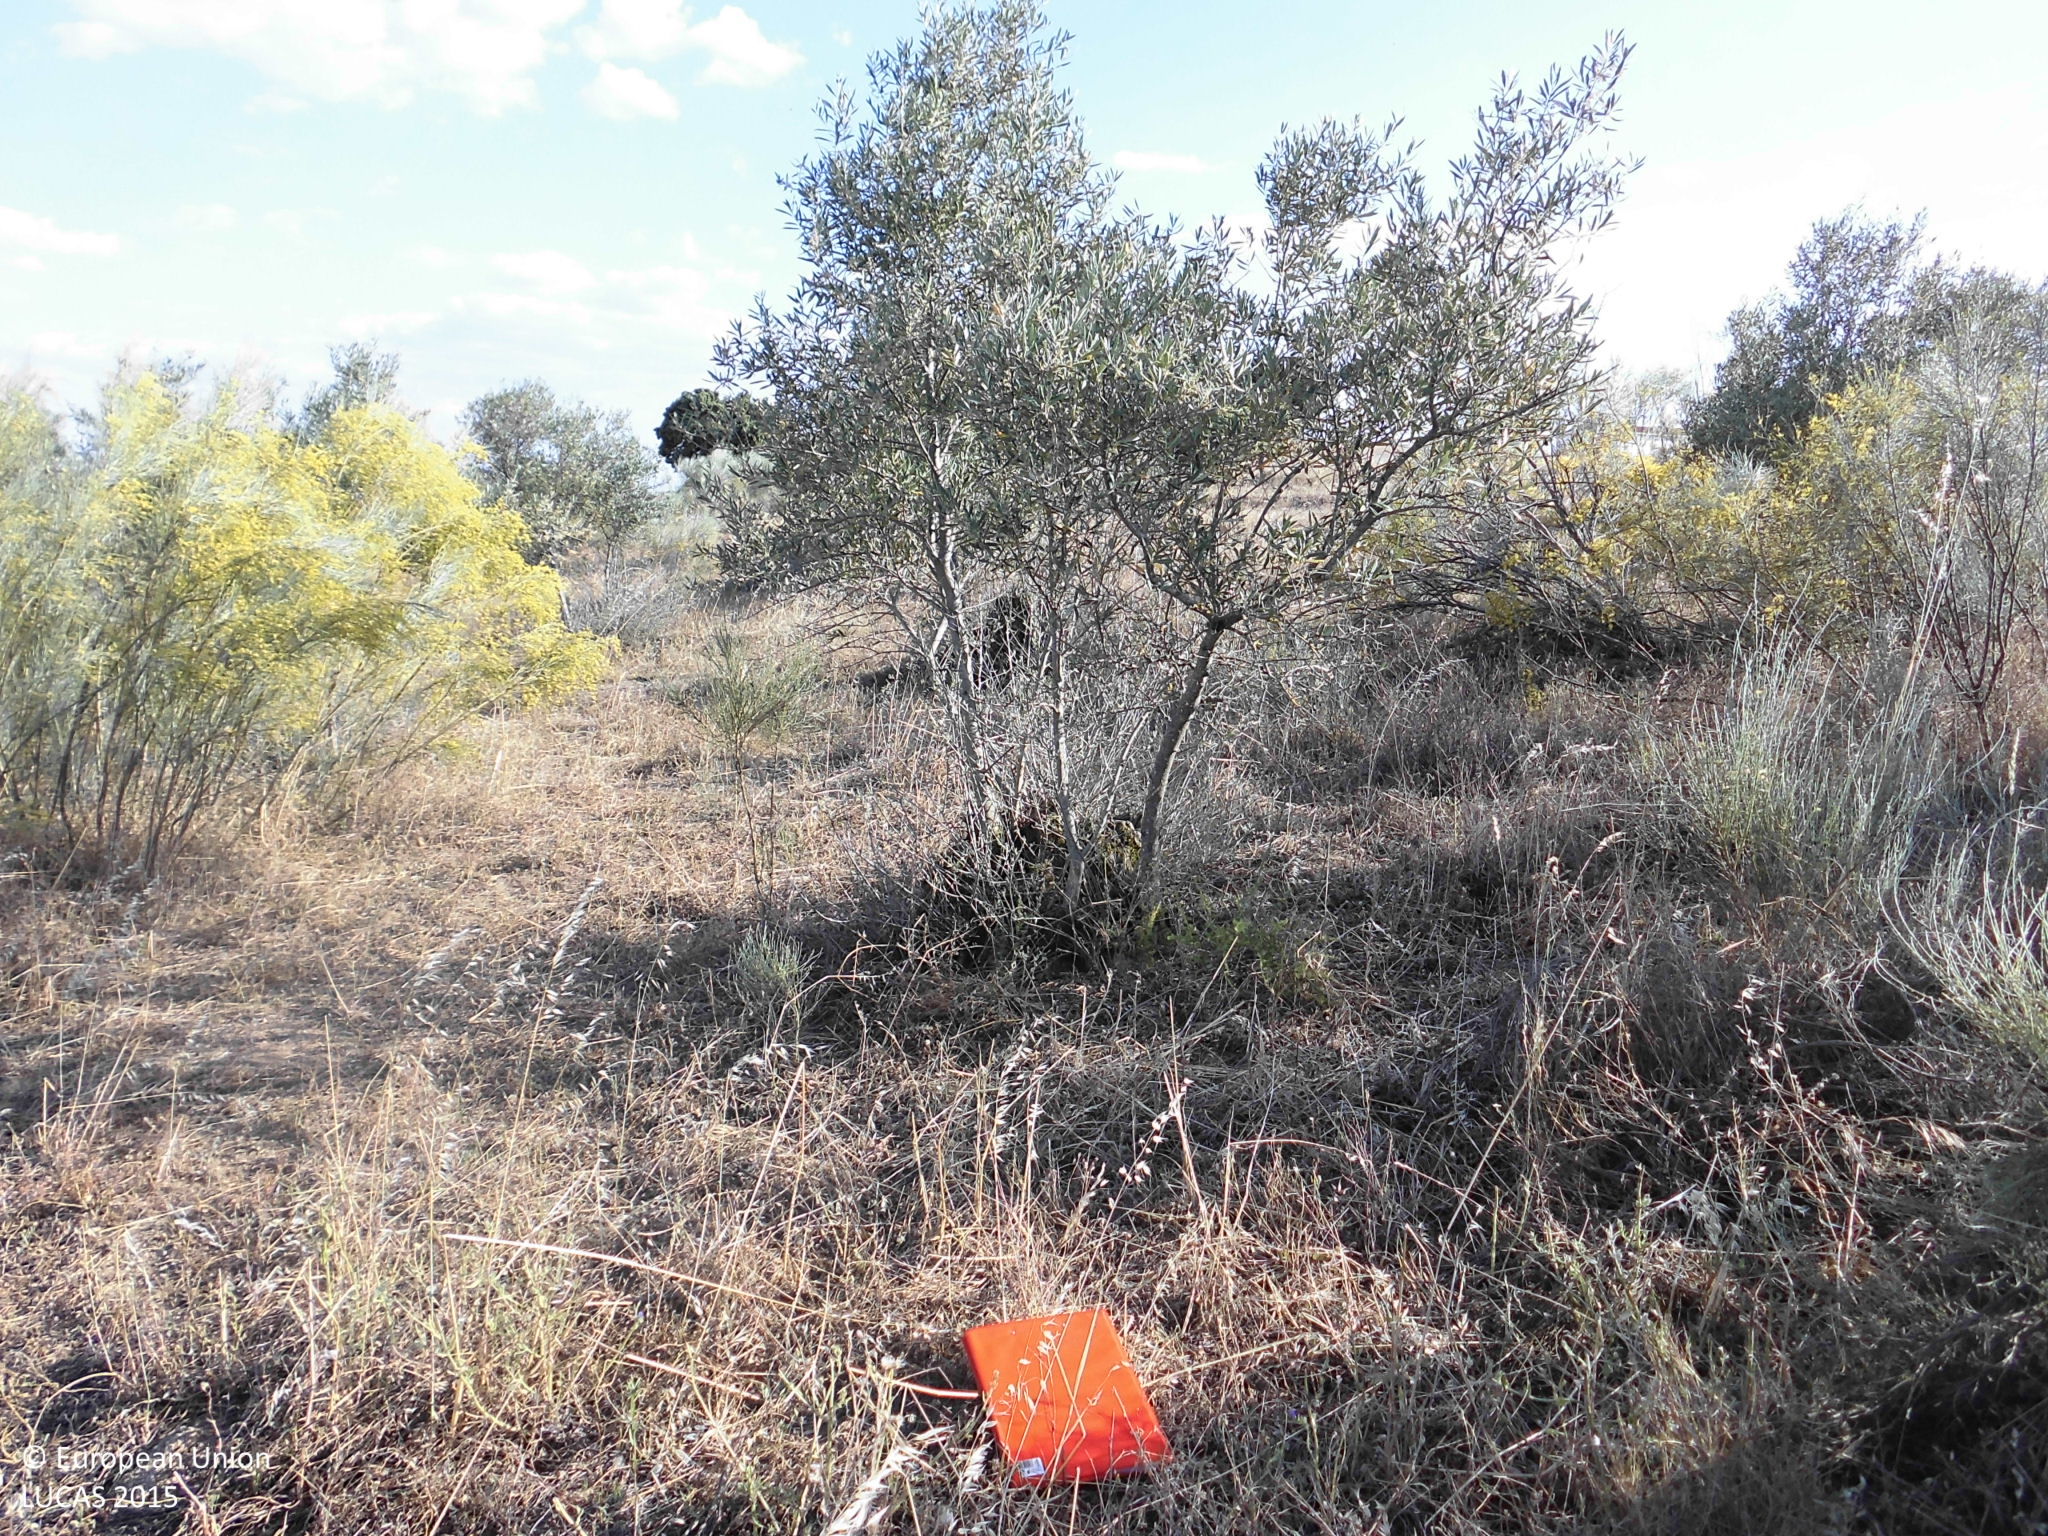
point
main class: Cropland
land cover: Olive groves
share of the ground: > 75 %
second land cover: Shrubland without tree cover
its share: > 75 %
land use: Abandoned areas
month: May
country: ES
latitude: 39.5858
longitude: -6.6676
